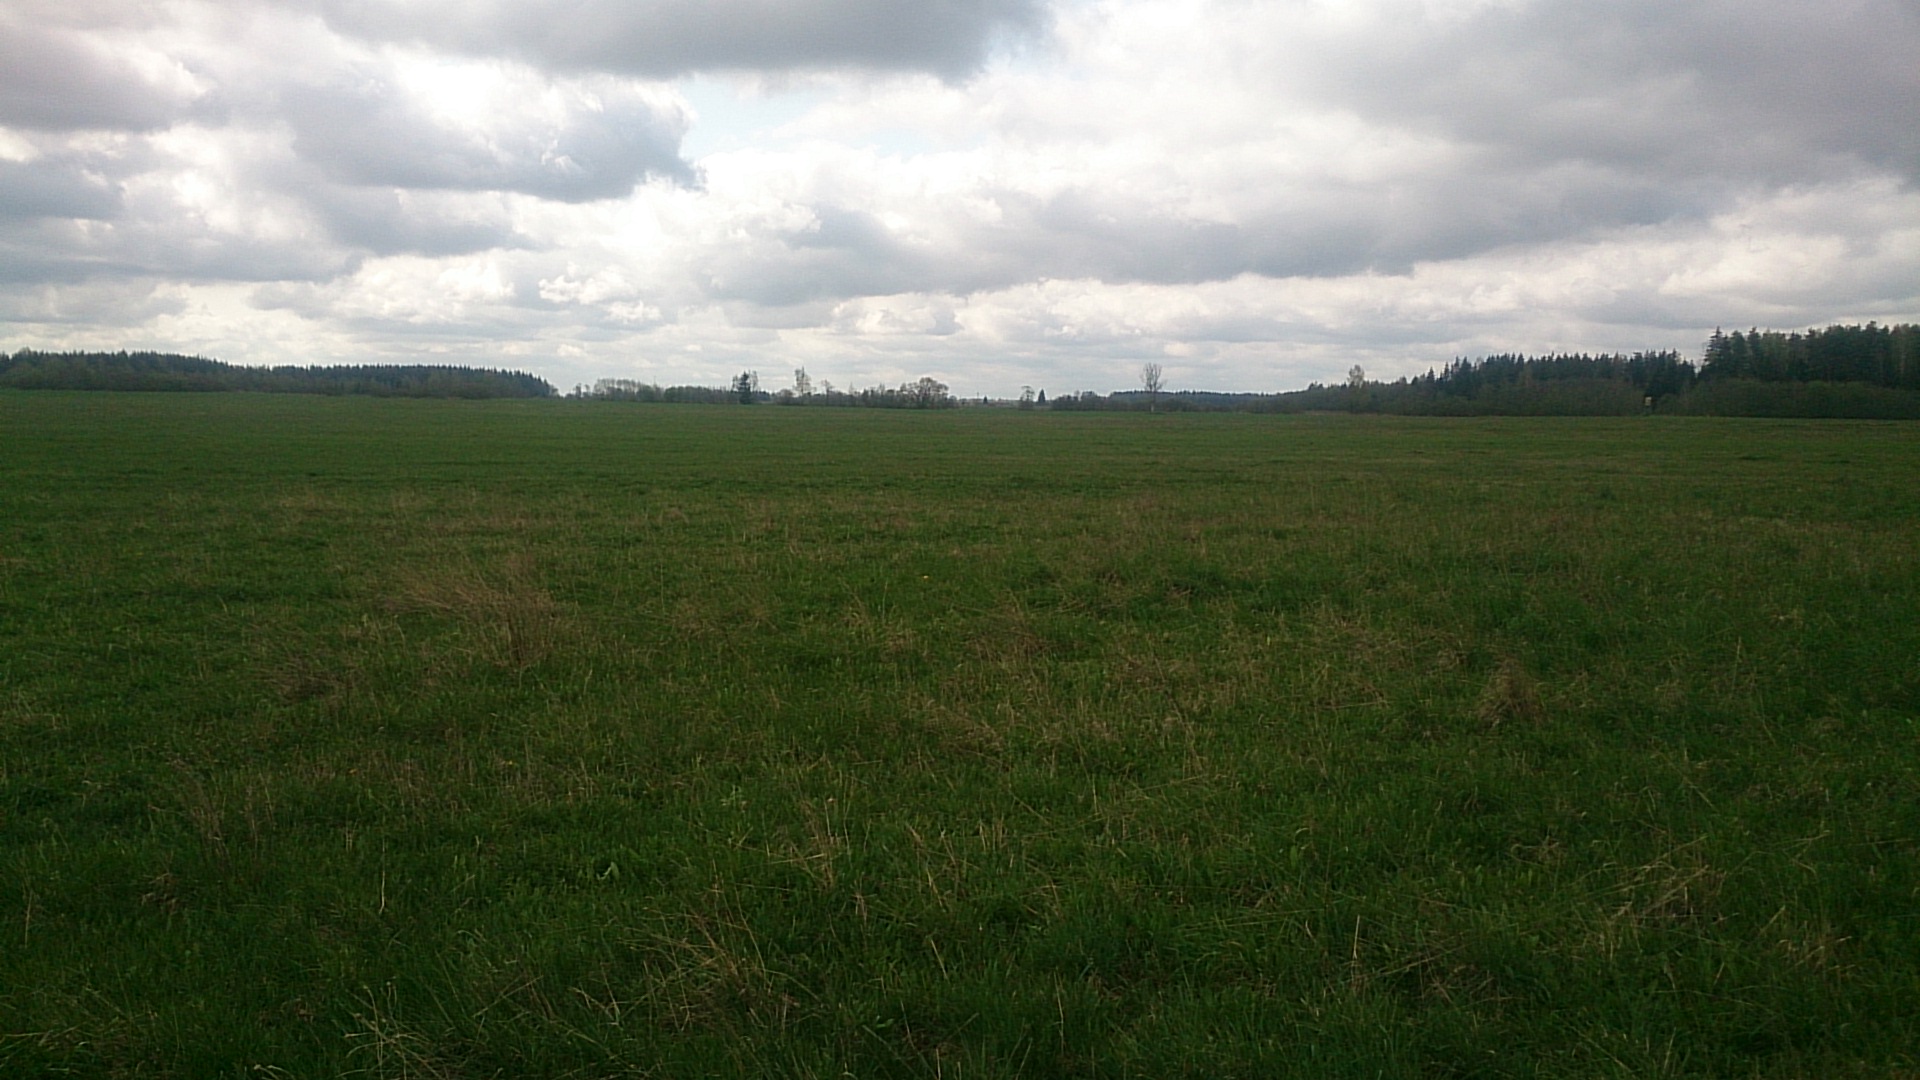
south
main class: Grassland
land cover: Grassland without tree/shrub cover
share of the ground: > 75 %
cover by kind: herbaceous plants 100 %
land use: Agriculture (excluding fallow land and kitchen gardens)
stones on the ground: < 10 %
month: May
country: LT
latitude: 56.3672
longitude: 22.0136
